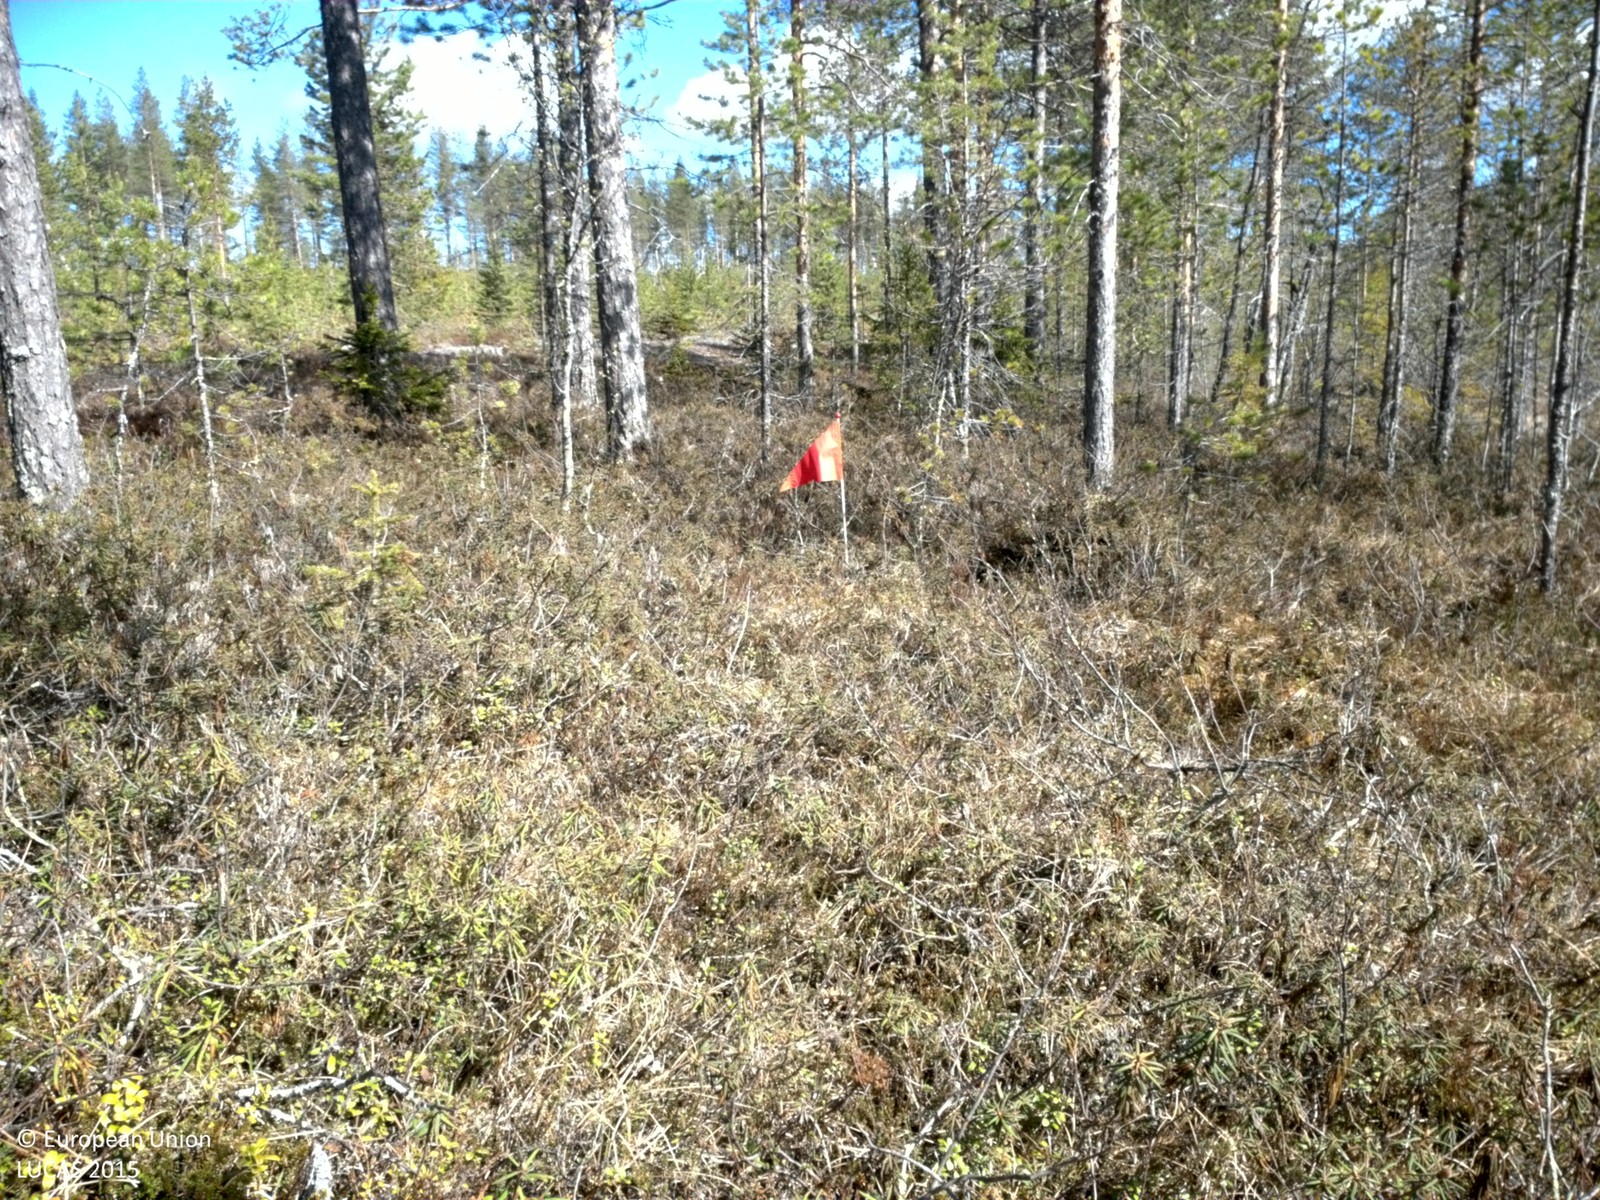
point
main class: Woodland
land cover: Pine dominated coniferous woodland
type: boreal forest
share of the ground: 25 - 50 %
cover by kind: shrubs 55 %, coniferous forest trees 45 %
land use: Forestry
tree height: > 5 m
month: May
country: SE
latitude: 66.1056
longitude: 23.1938
